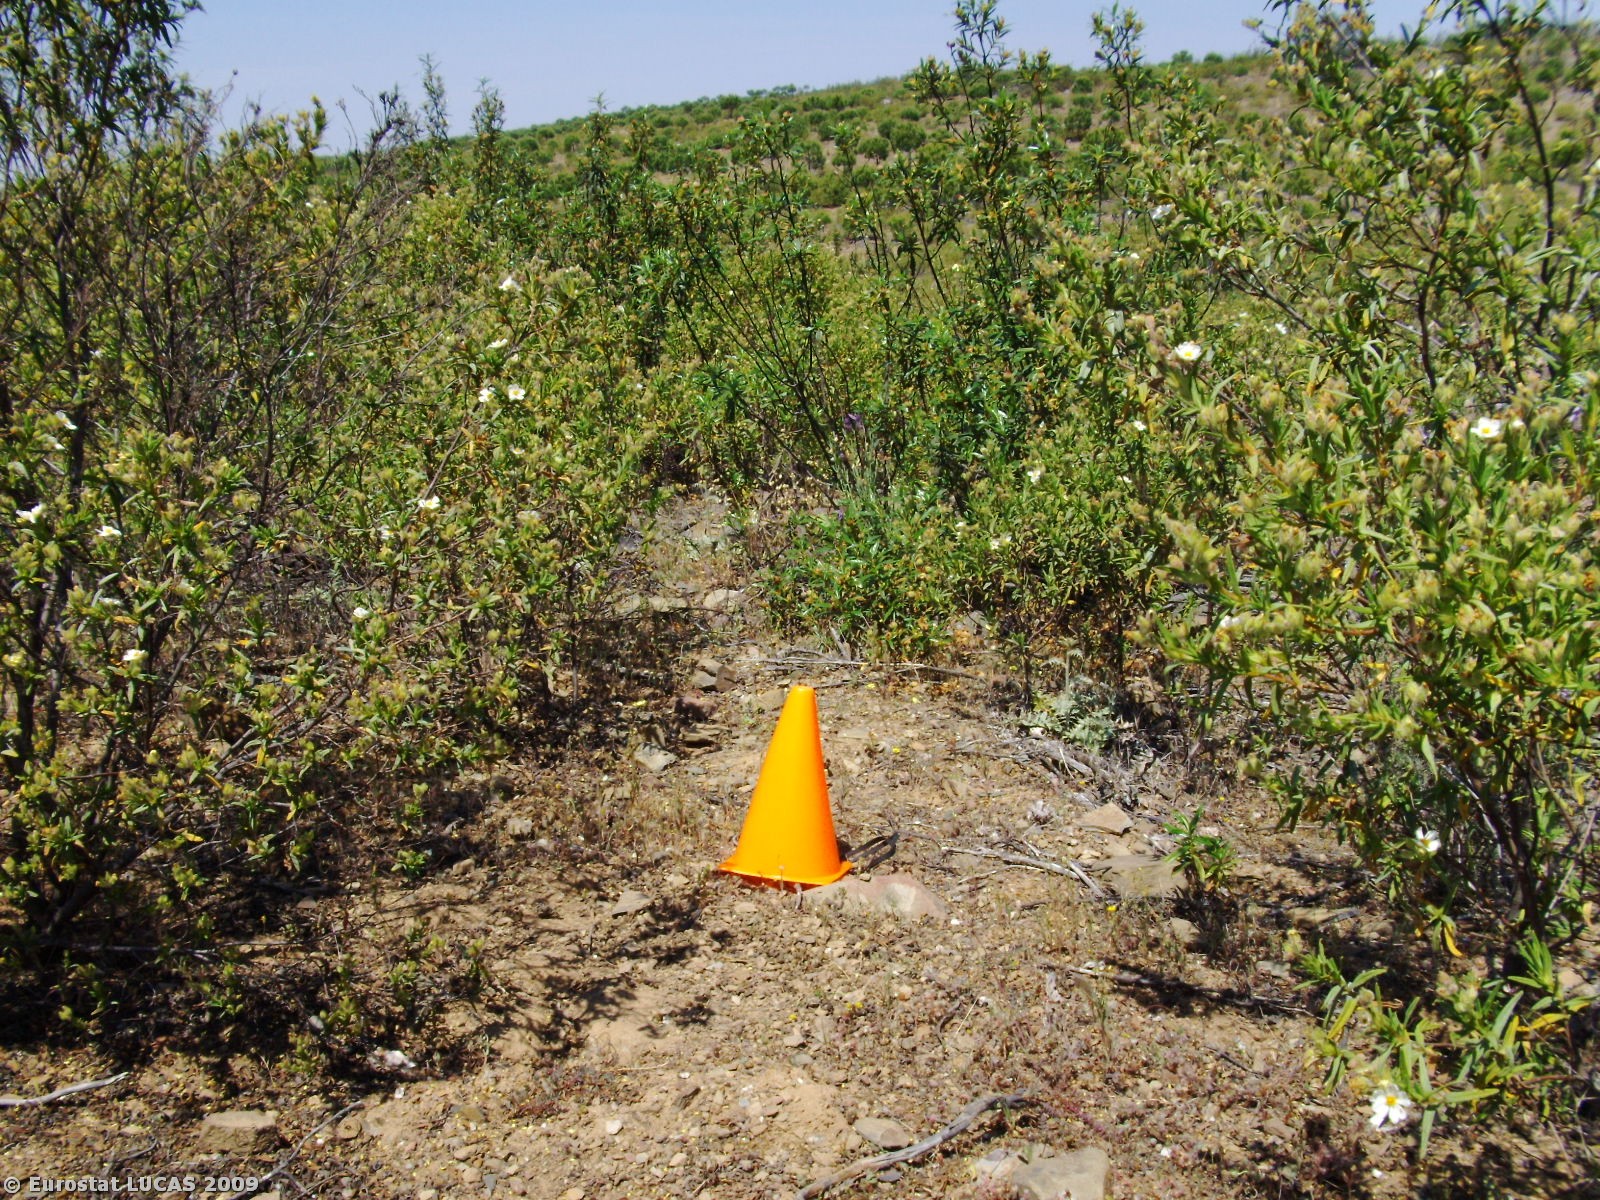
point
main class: Shrubland
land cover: Shrubland without tree cover
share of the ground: 50 - 75 %
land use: Unused
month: May
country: PT
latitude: 37.4356
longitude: -7.5379
